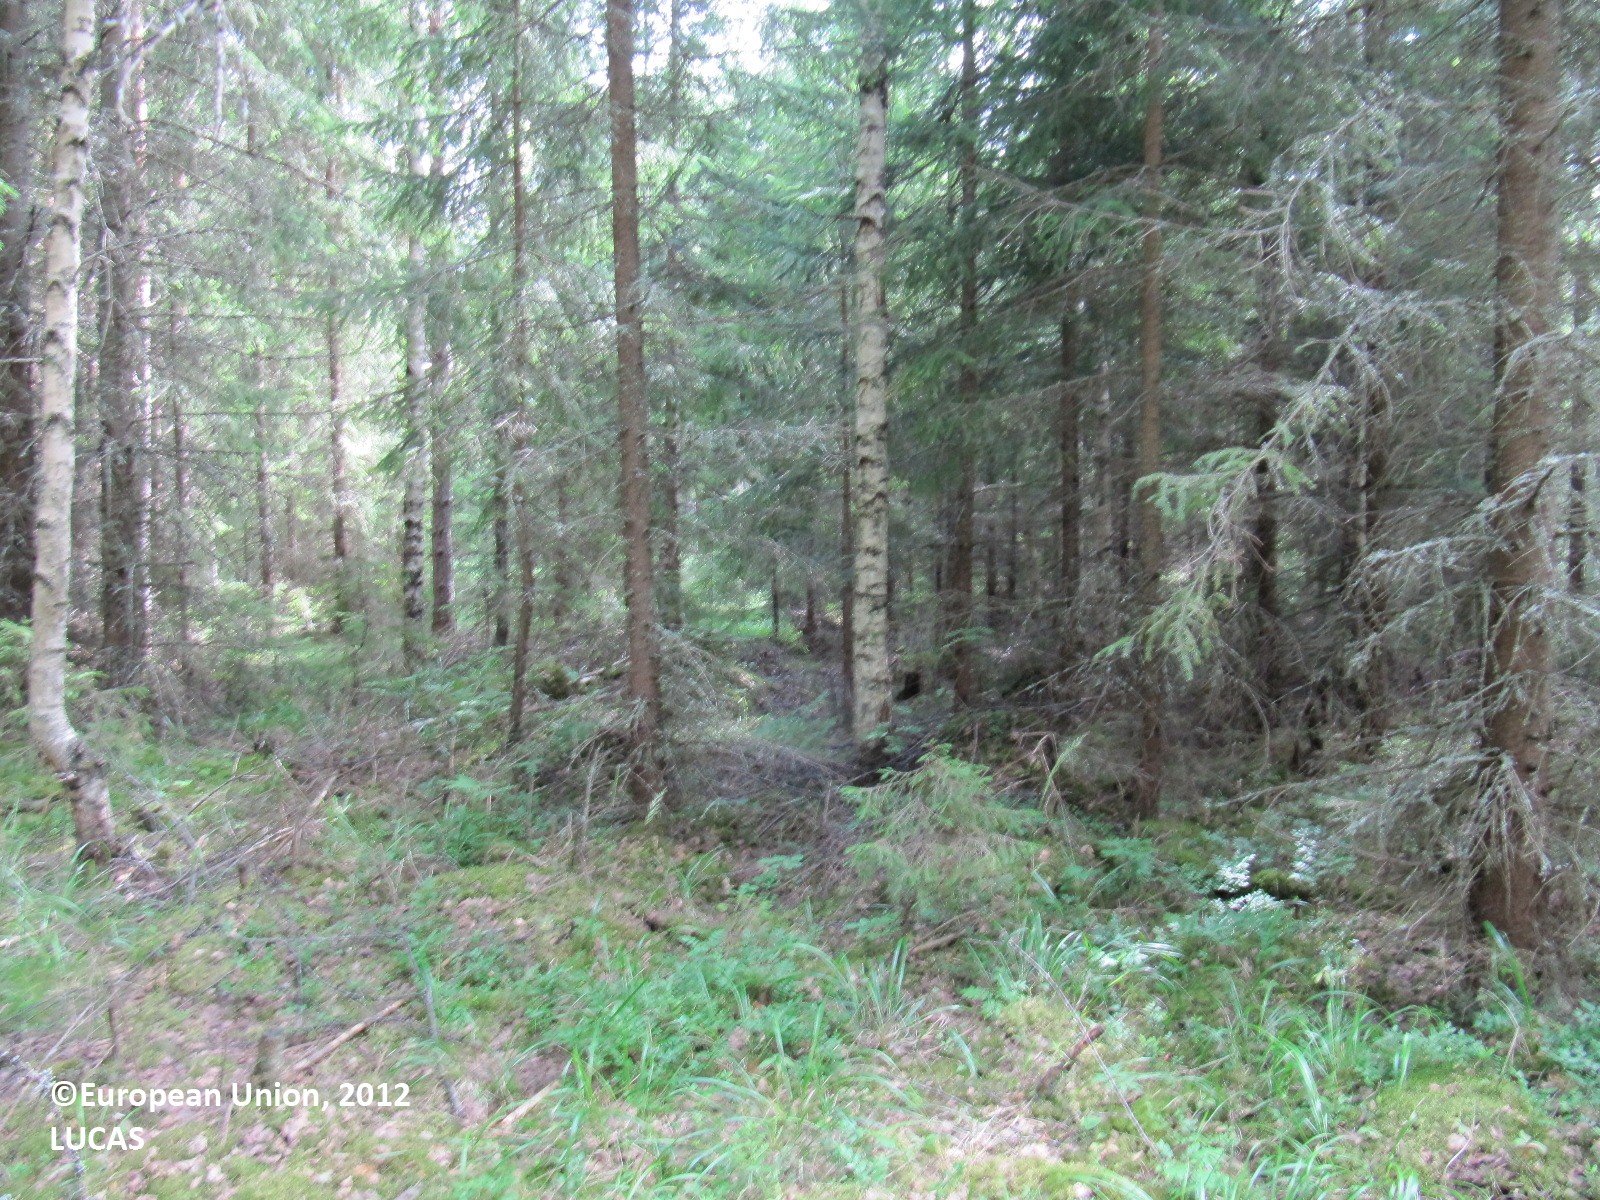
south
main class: Woodland
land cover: Spruce dominated mixed woodland
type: boreal forest
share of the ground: > 75 %
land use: Forestry
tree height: > 5 m
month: July
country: FI
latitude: 61.0152
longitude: 24.2117
